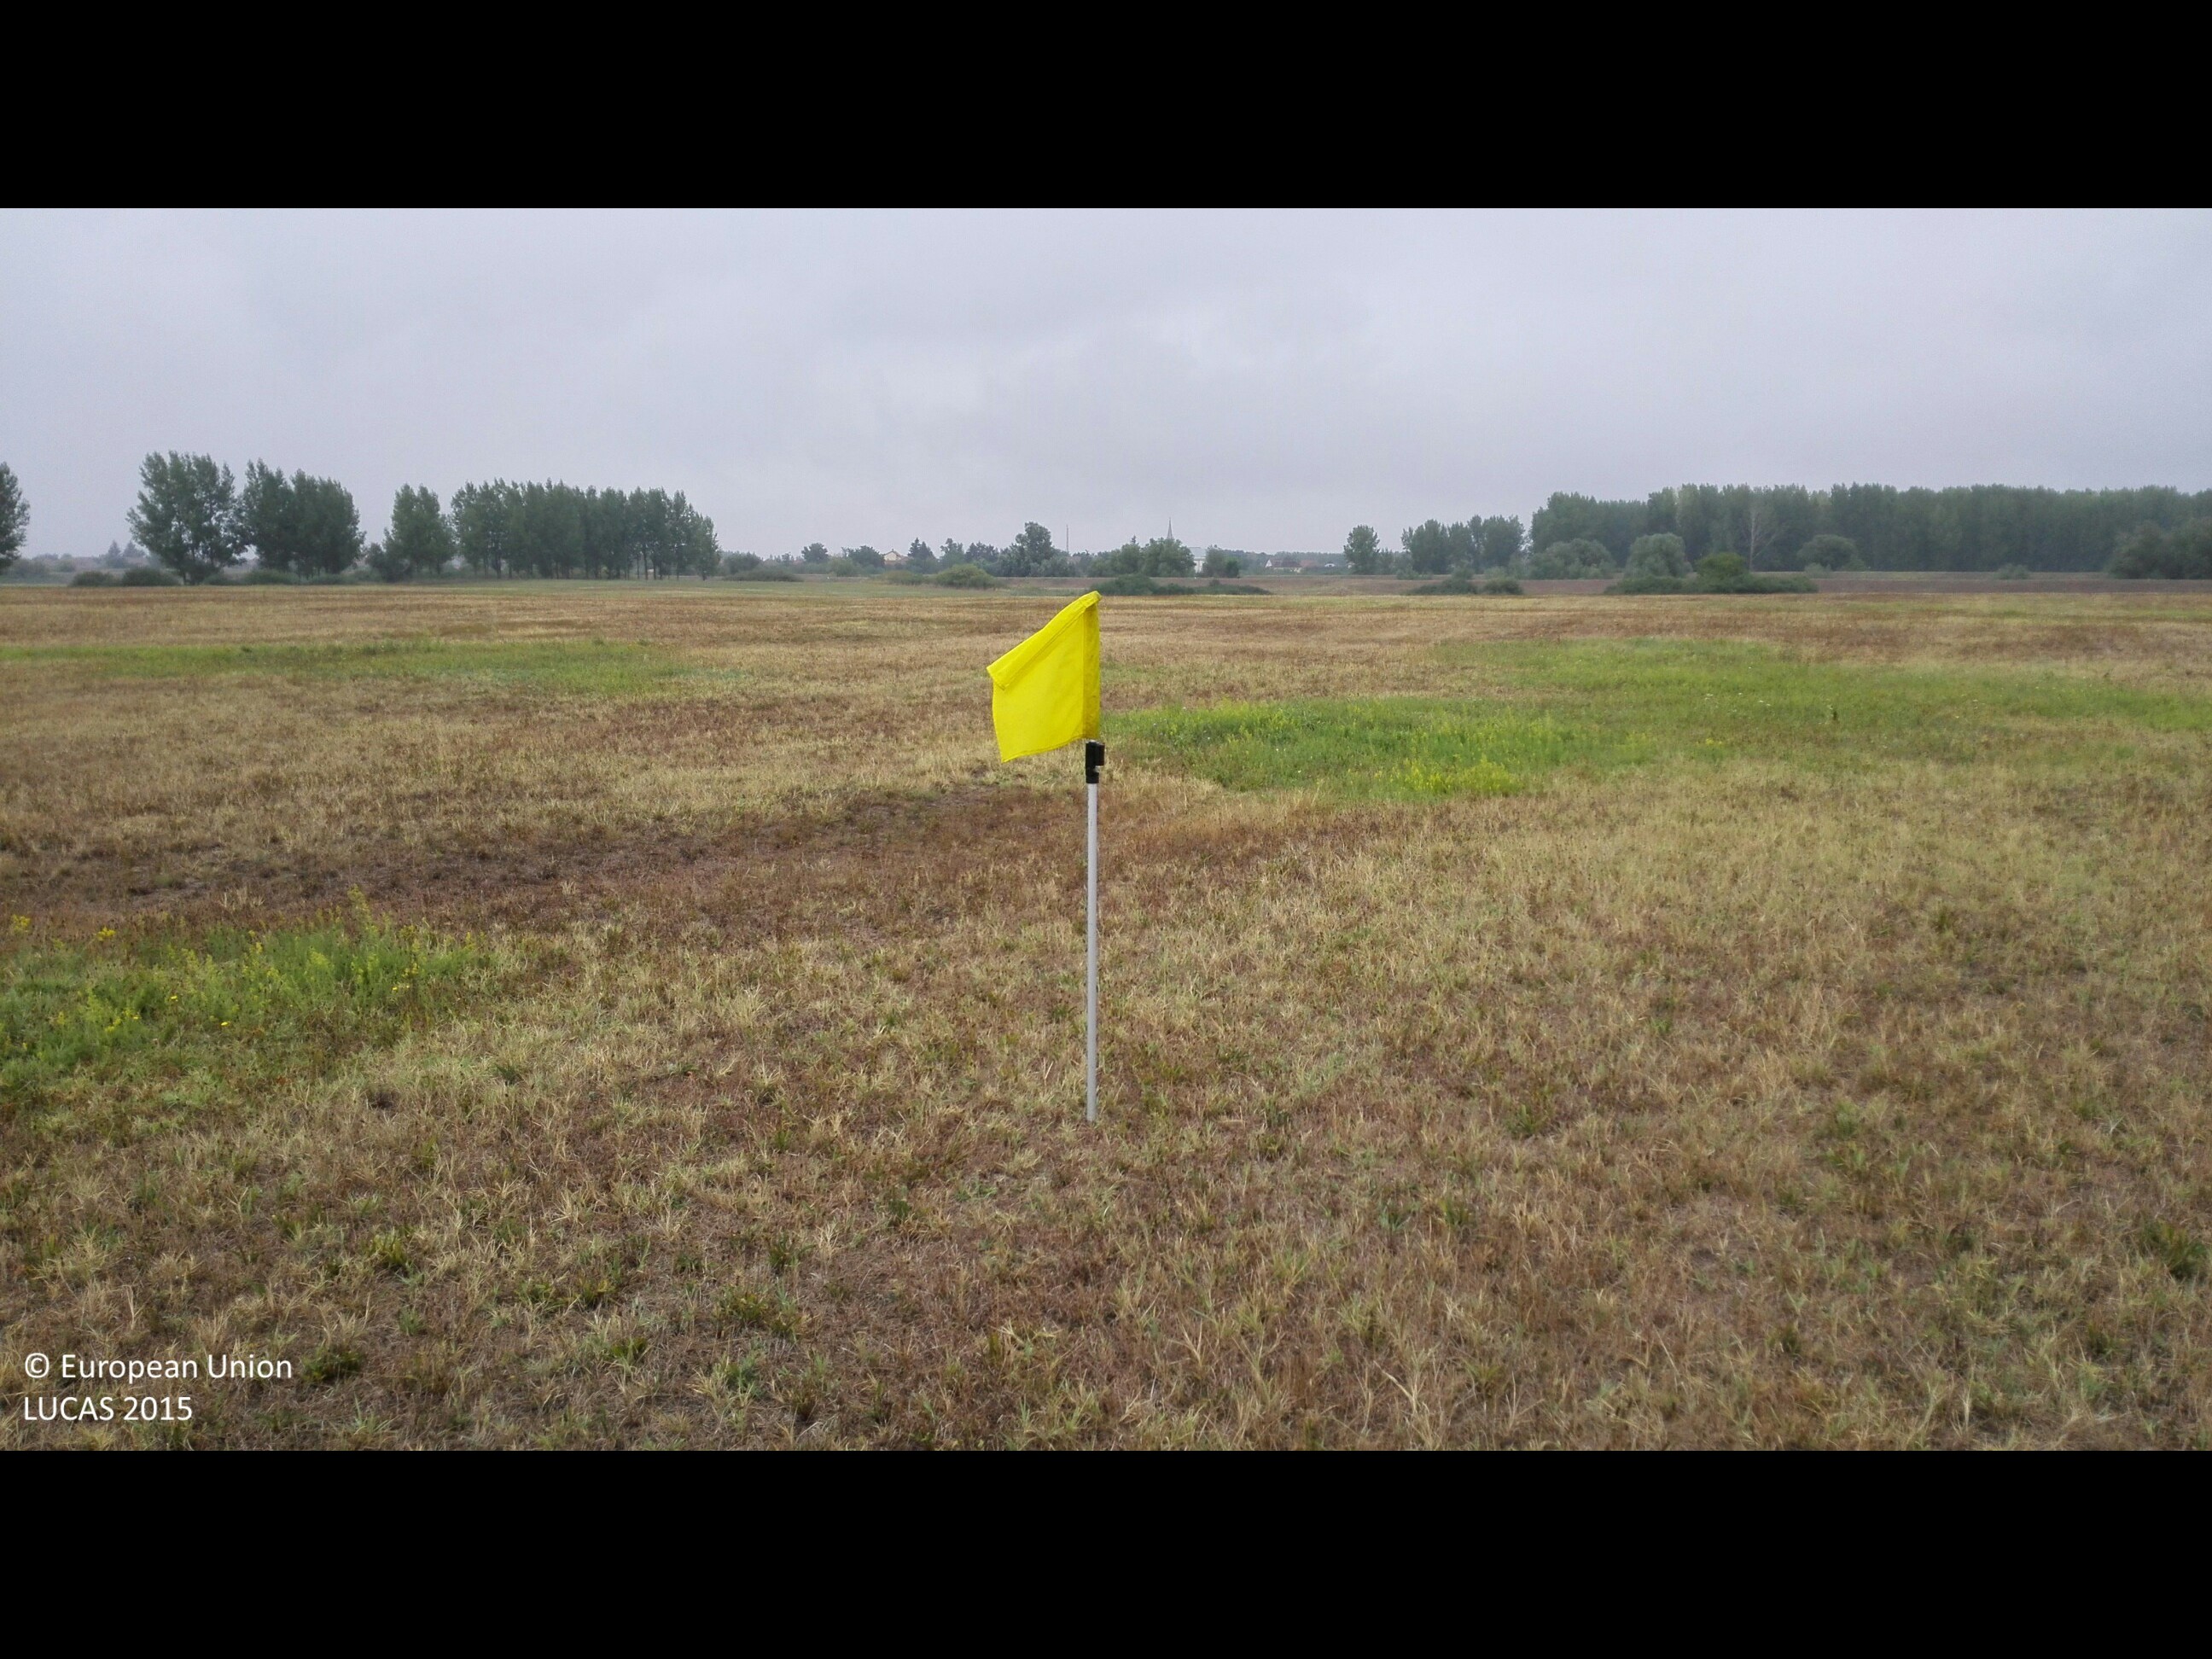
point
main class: Grassland
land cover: Grassland without tree/shrub cover
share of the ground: > 75 %
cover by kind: herbaceous plants 100 %
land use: Agriculture (excluding fallow land and kitchen gardens)
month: August
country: HU
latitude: 47.2755
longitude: 21.8242
